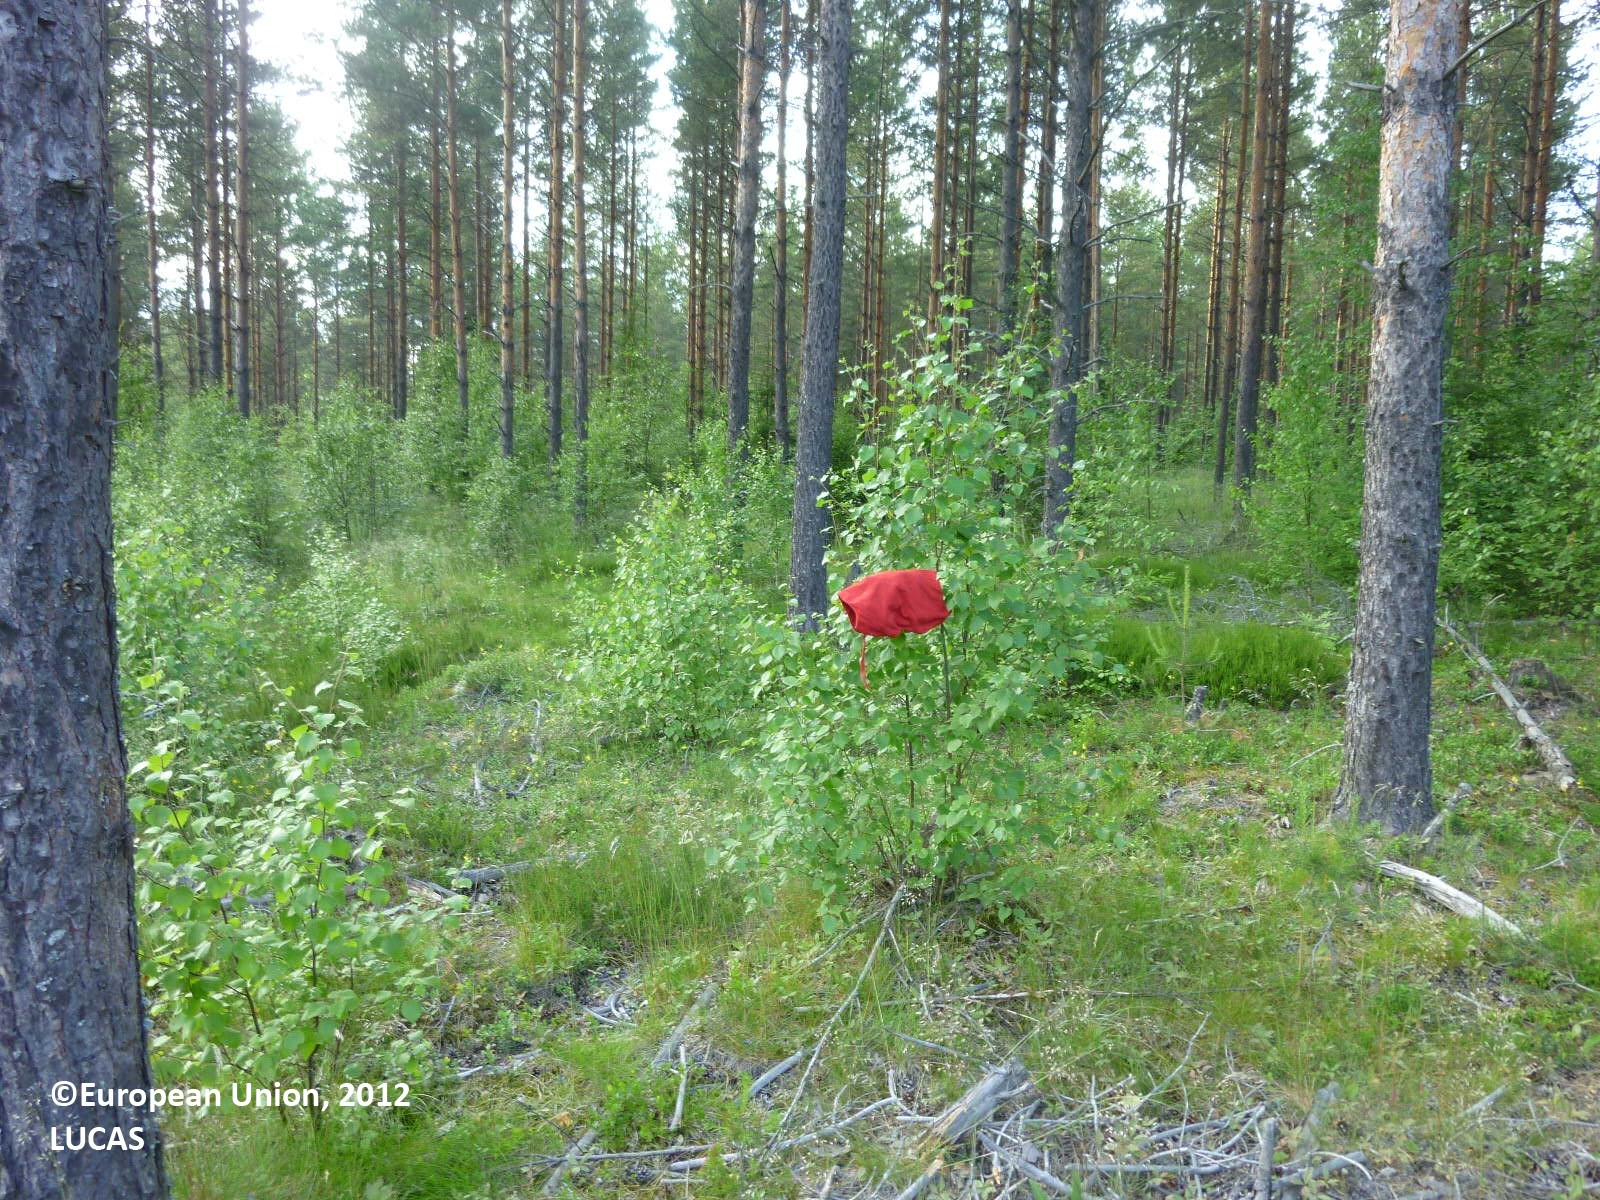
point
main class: Woodland
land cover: Pine dominated coniferous woodland
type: boreal forest
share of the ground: 50 - 75 %
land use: Forestry
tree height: > 5 m
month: July
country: FI
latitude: 61.1661
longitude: 22.3880
